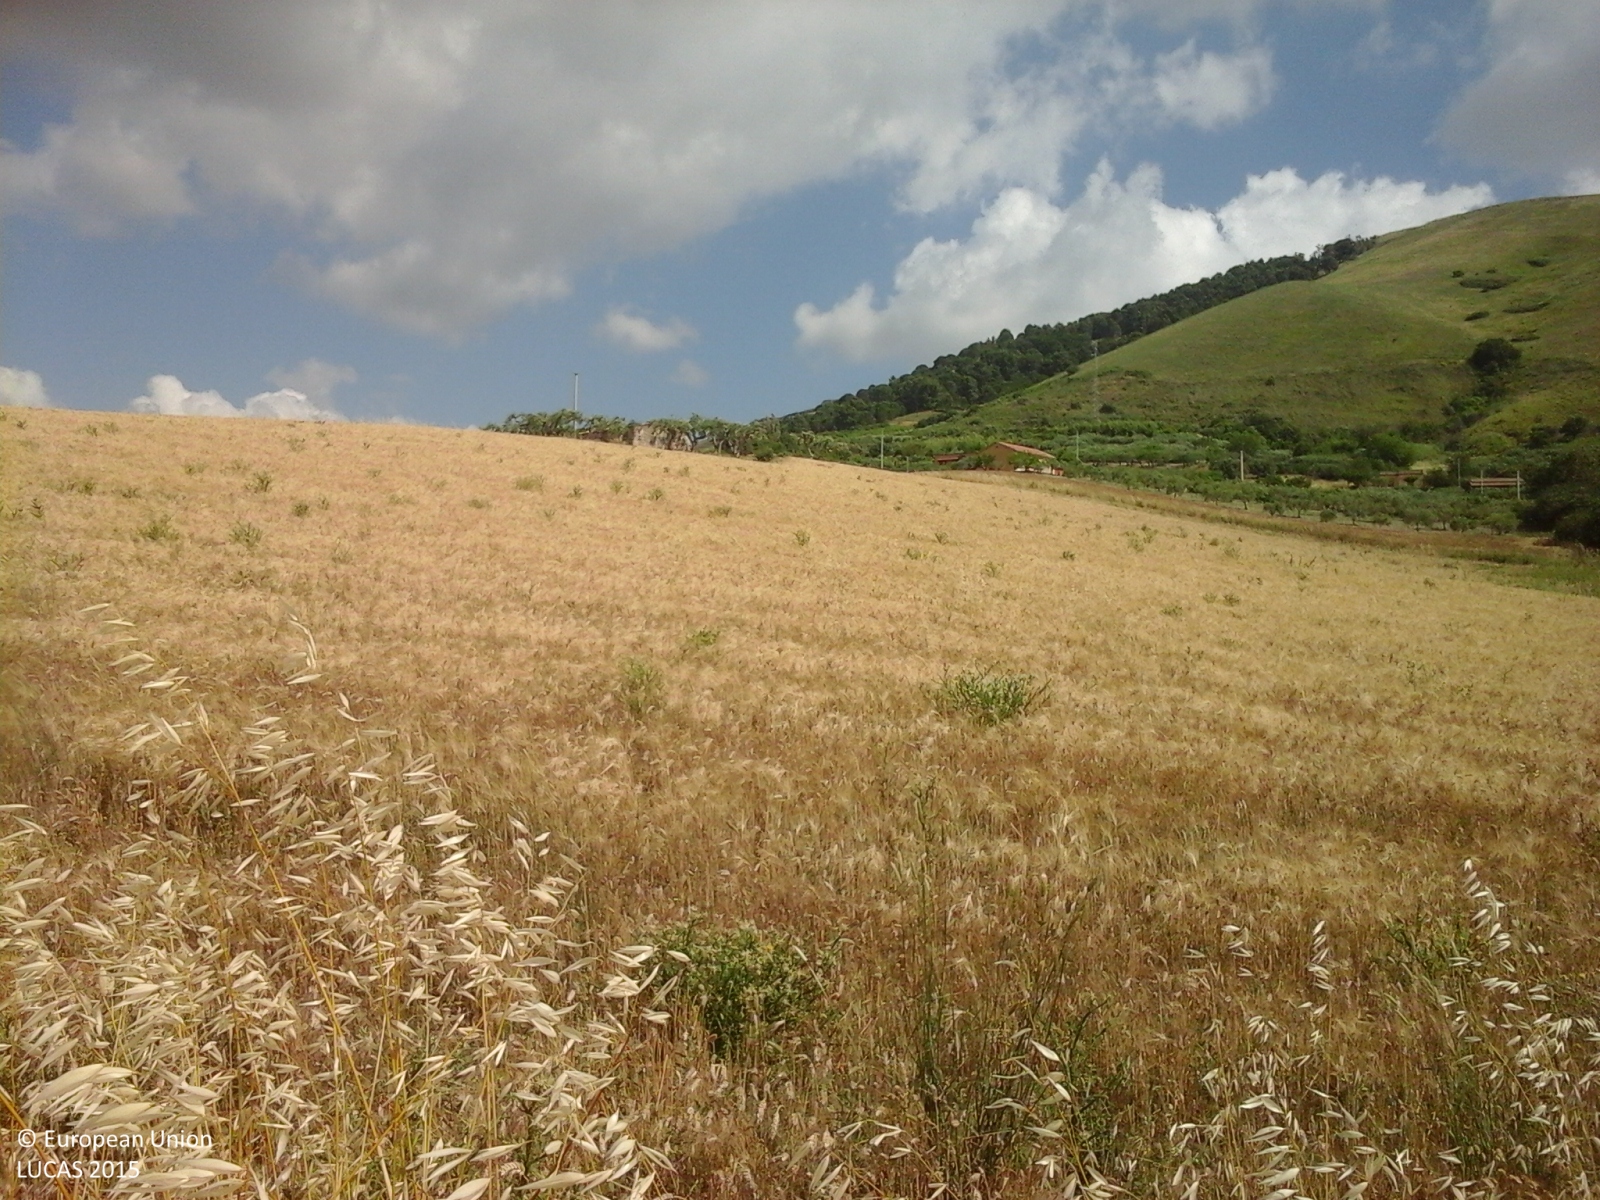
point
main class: Cropland
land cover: Durum wheat
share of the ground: > 75 %
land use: Agriculture (excluding fallow land and kitchen gardens)
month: June
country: IT
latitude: 37.7320
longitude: 13.1424
